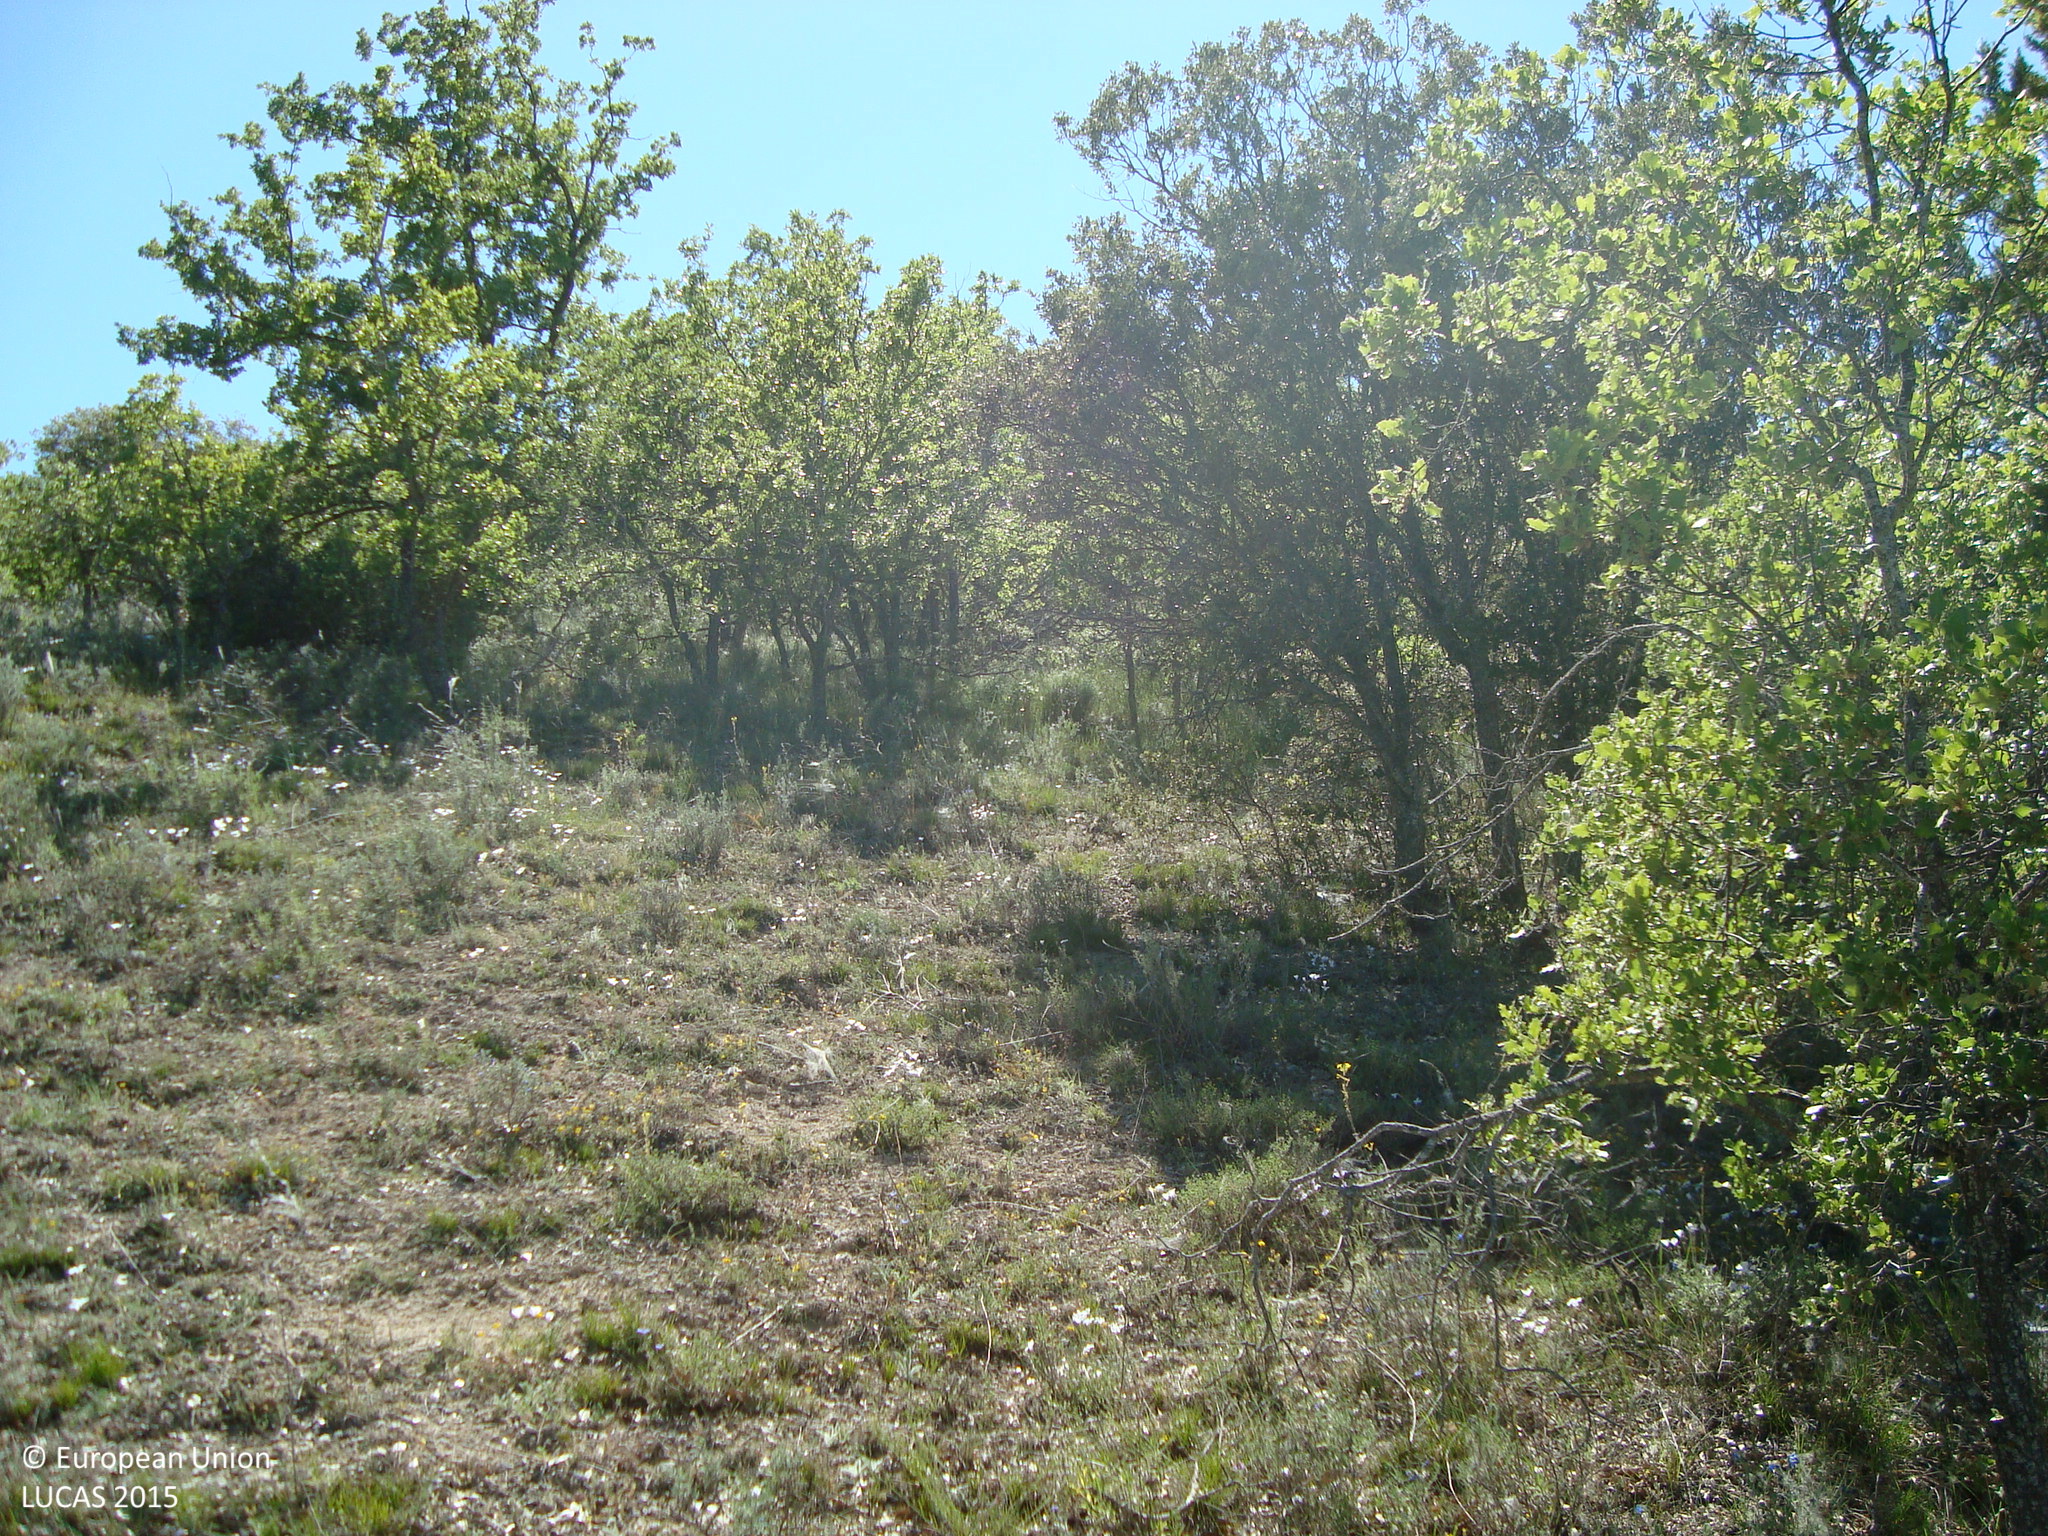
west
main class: Woodland
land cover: Broadleaved woodland
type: thermophilous deciduous forest
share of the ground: 50 - 75 %
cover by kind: broadleaved forest trees 55 %, herbaceous plants 25 %, shrubs 20 %
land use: Semi-natural and natural areas not in use
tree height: < 5 m
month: May
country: ES
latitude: 41.5062
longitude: -4.0374
